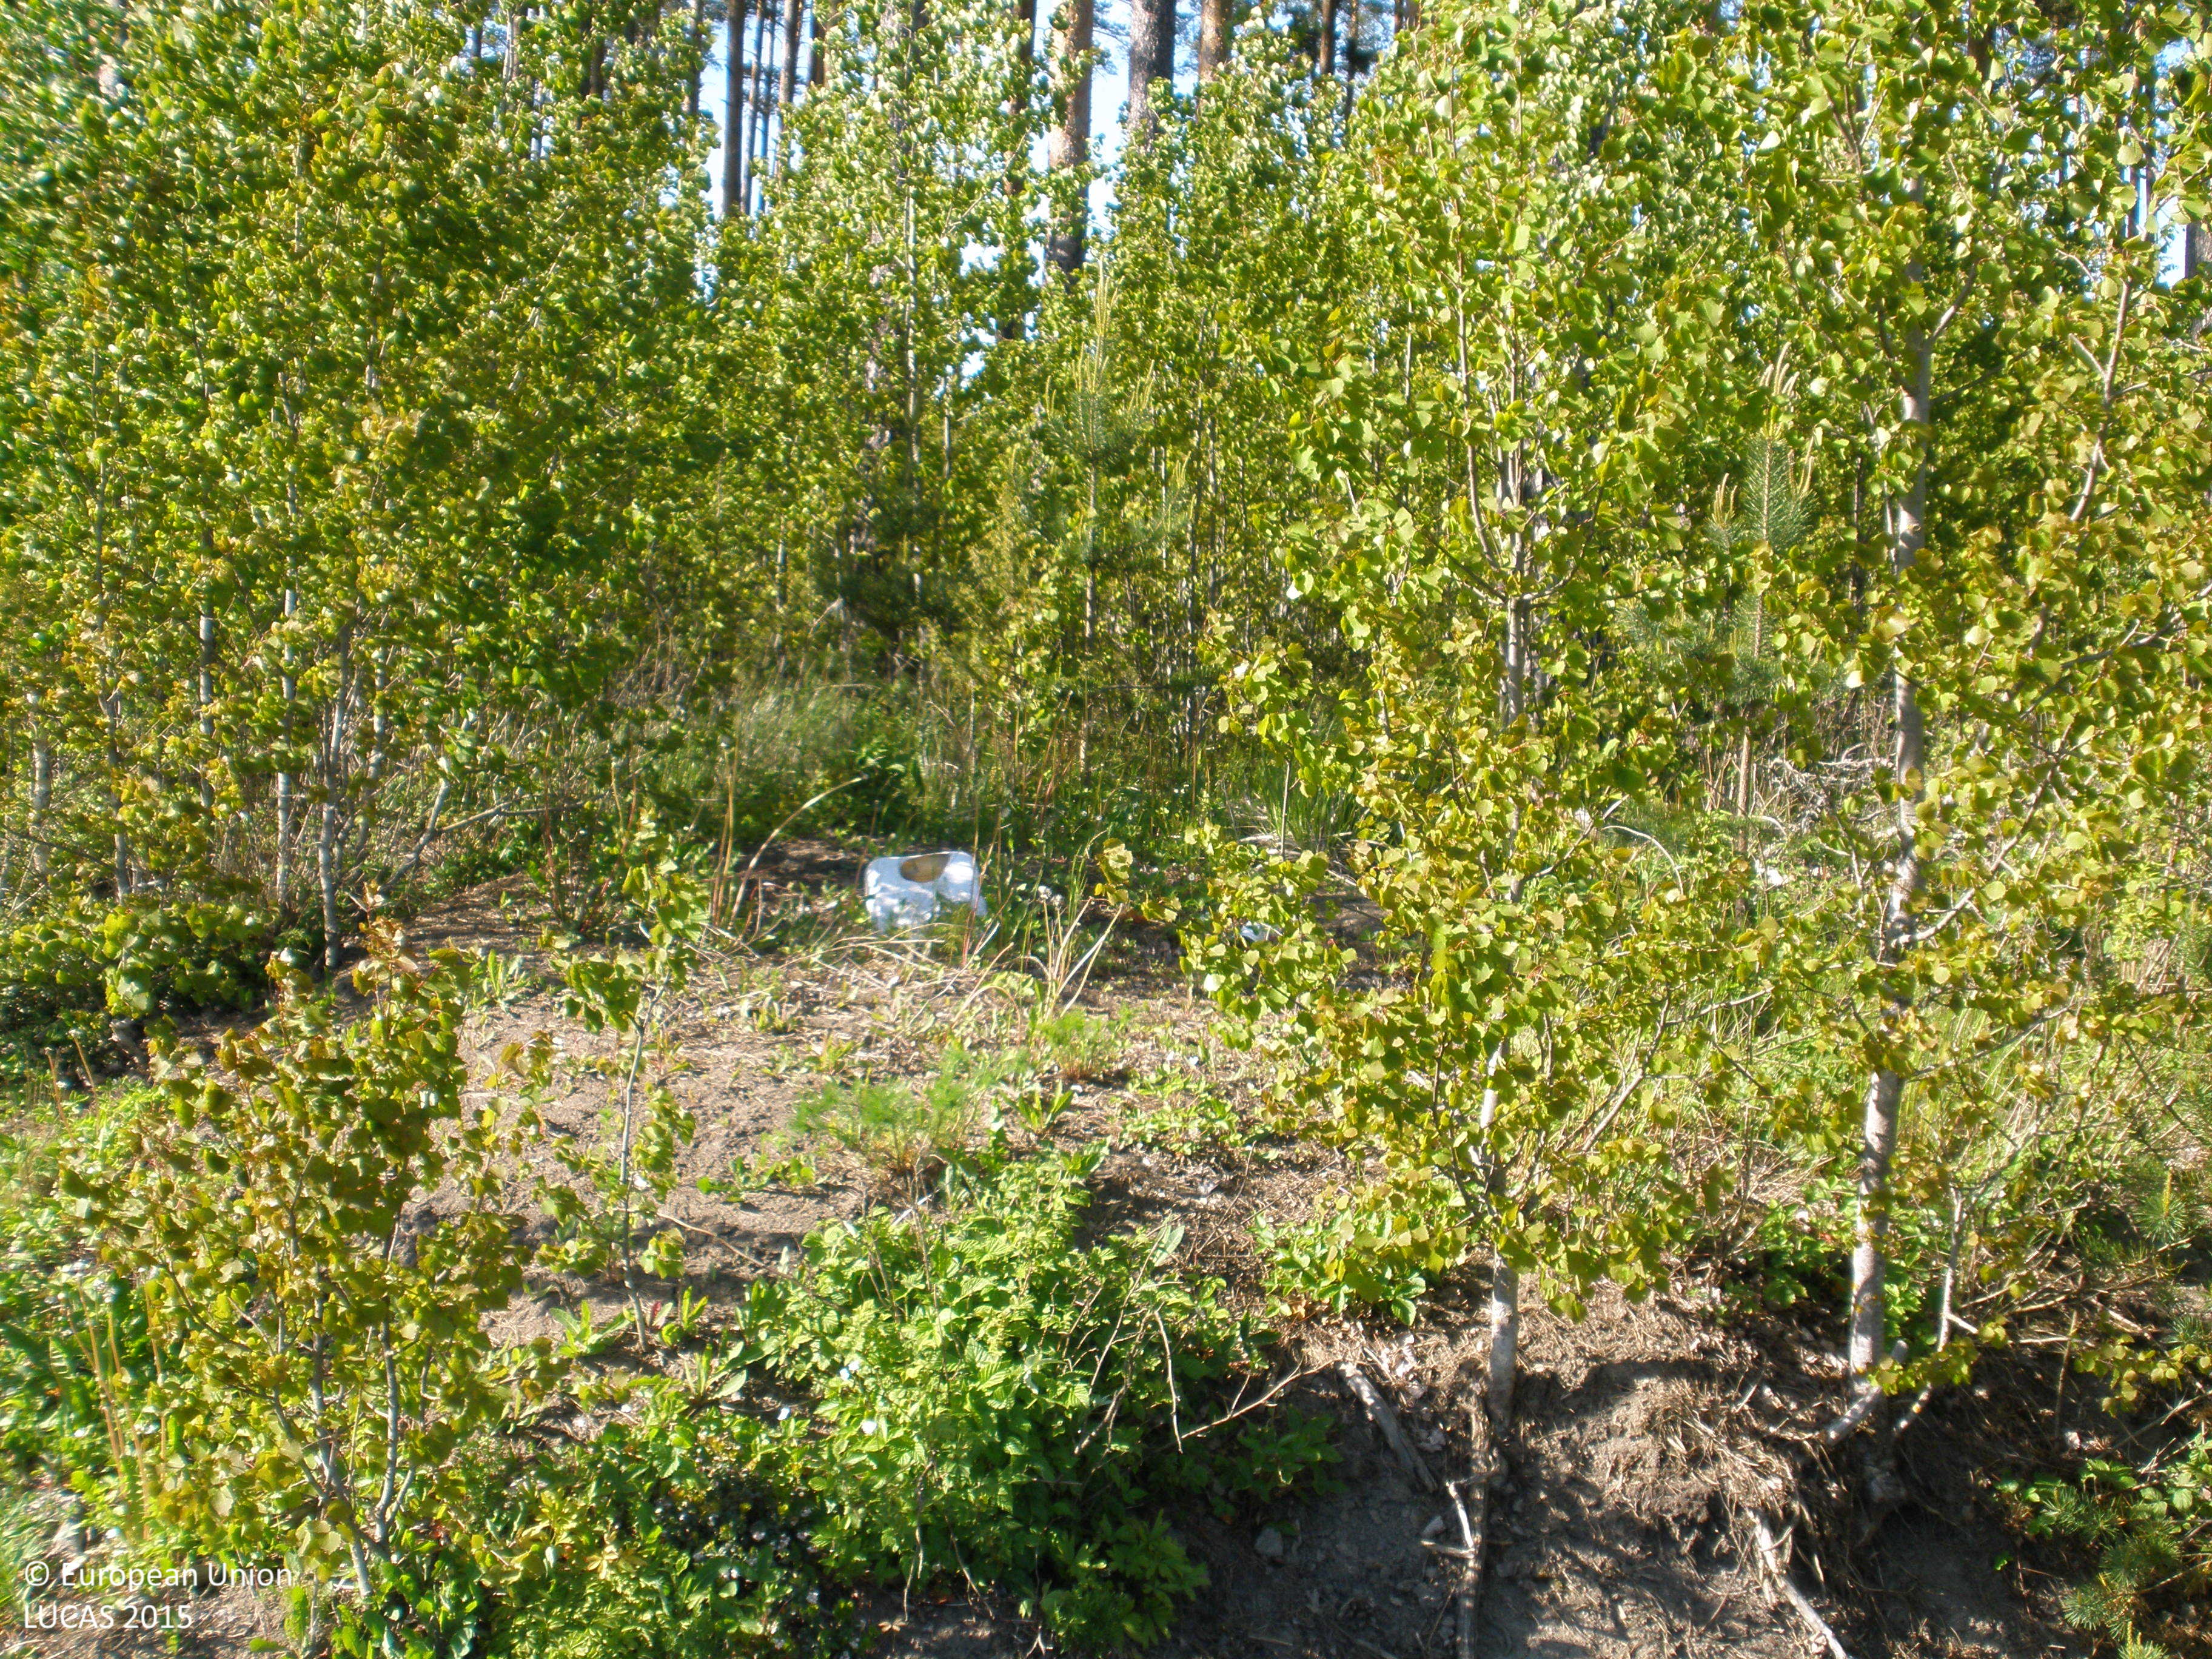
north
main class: Cropland
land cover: Common wheat
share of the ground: > 75 %
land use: Agriculture (excluding fallow land and kitchen gardens)
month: June
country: FI
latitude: 60.7613
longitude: 23.4264
